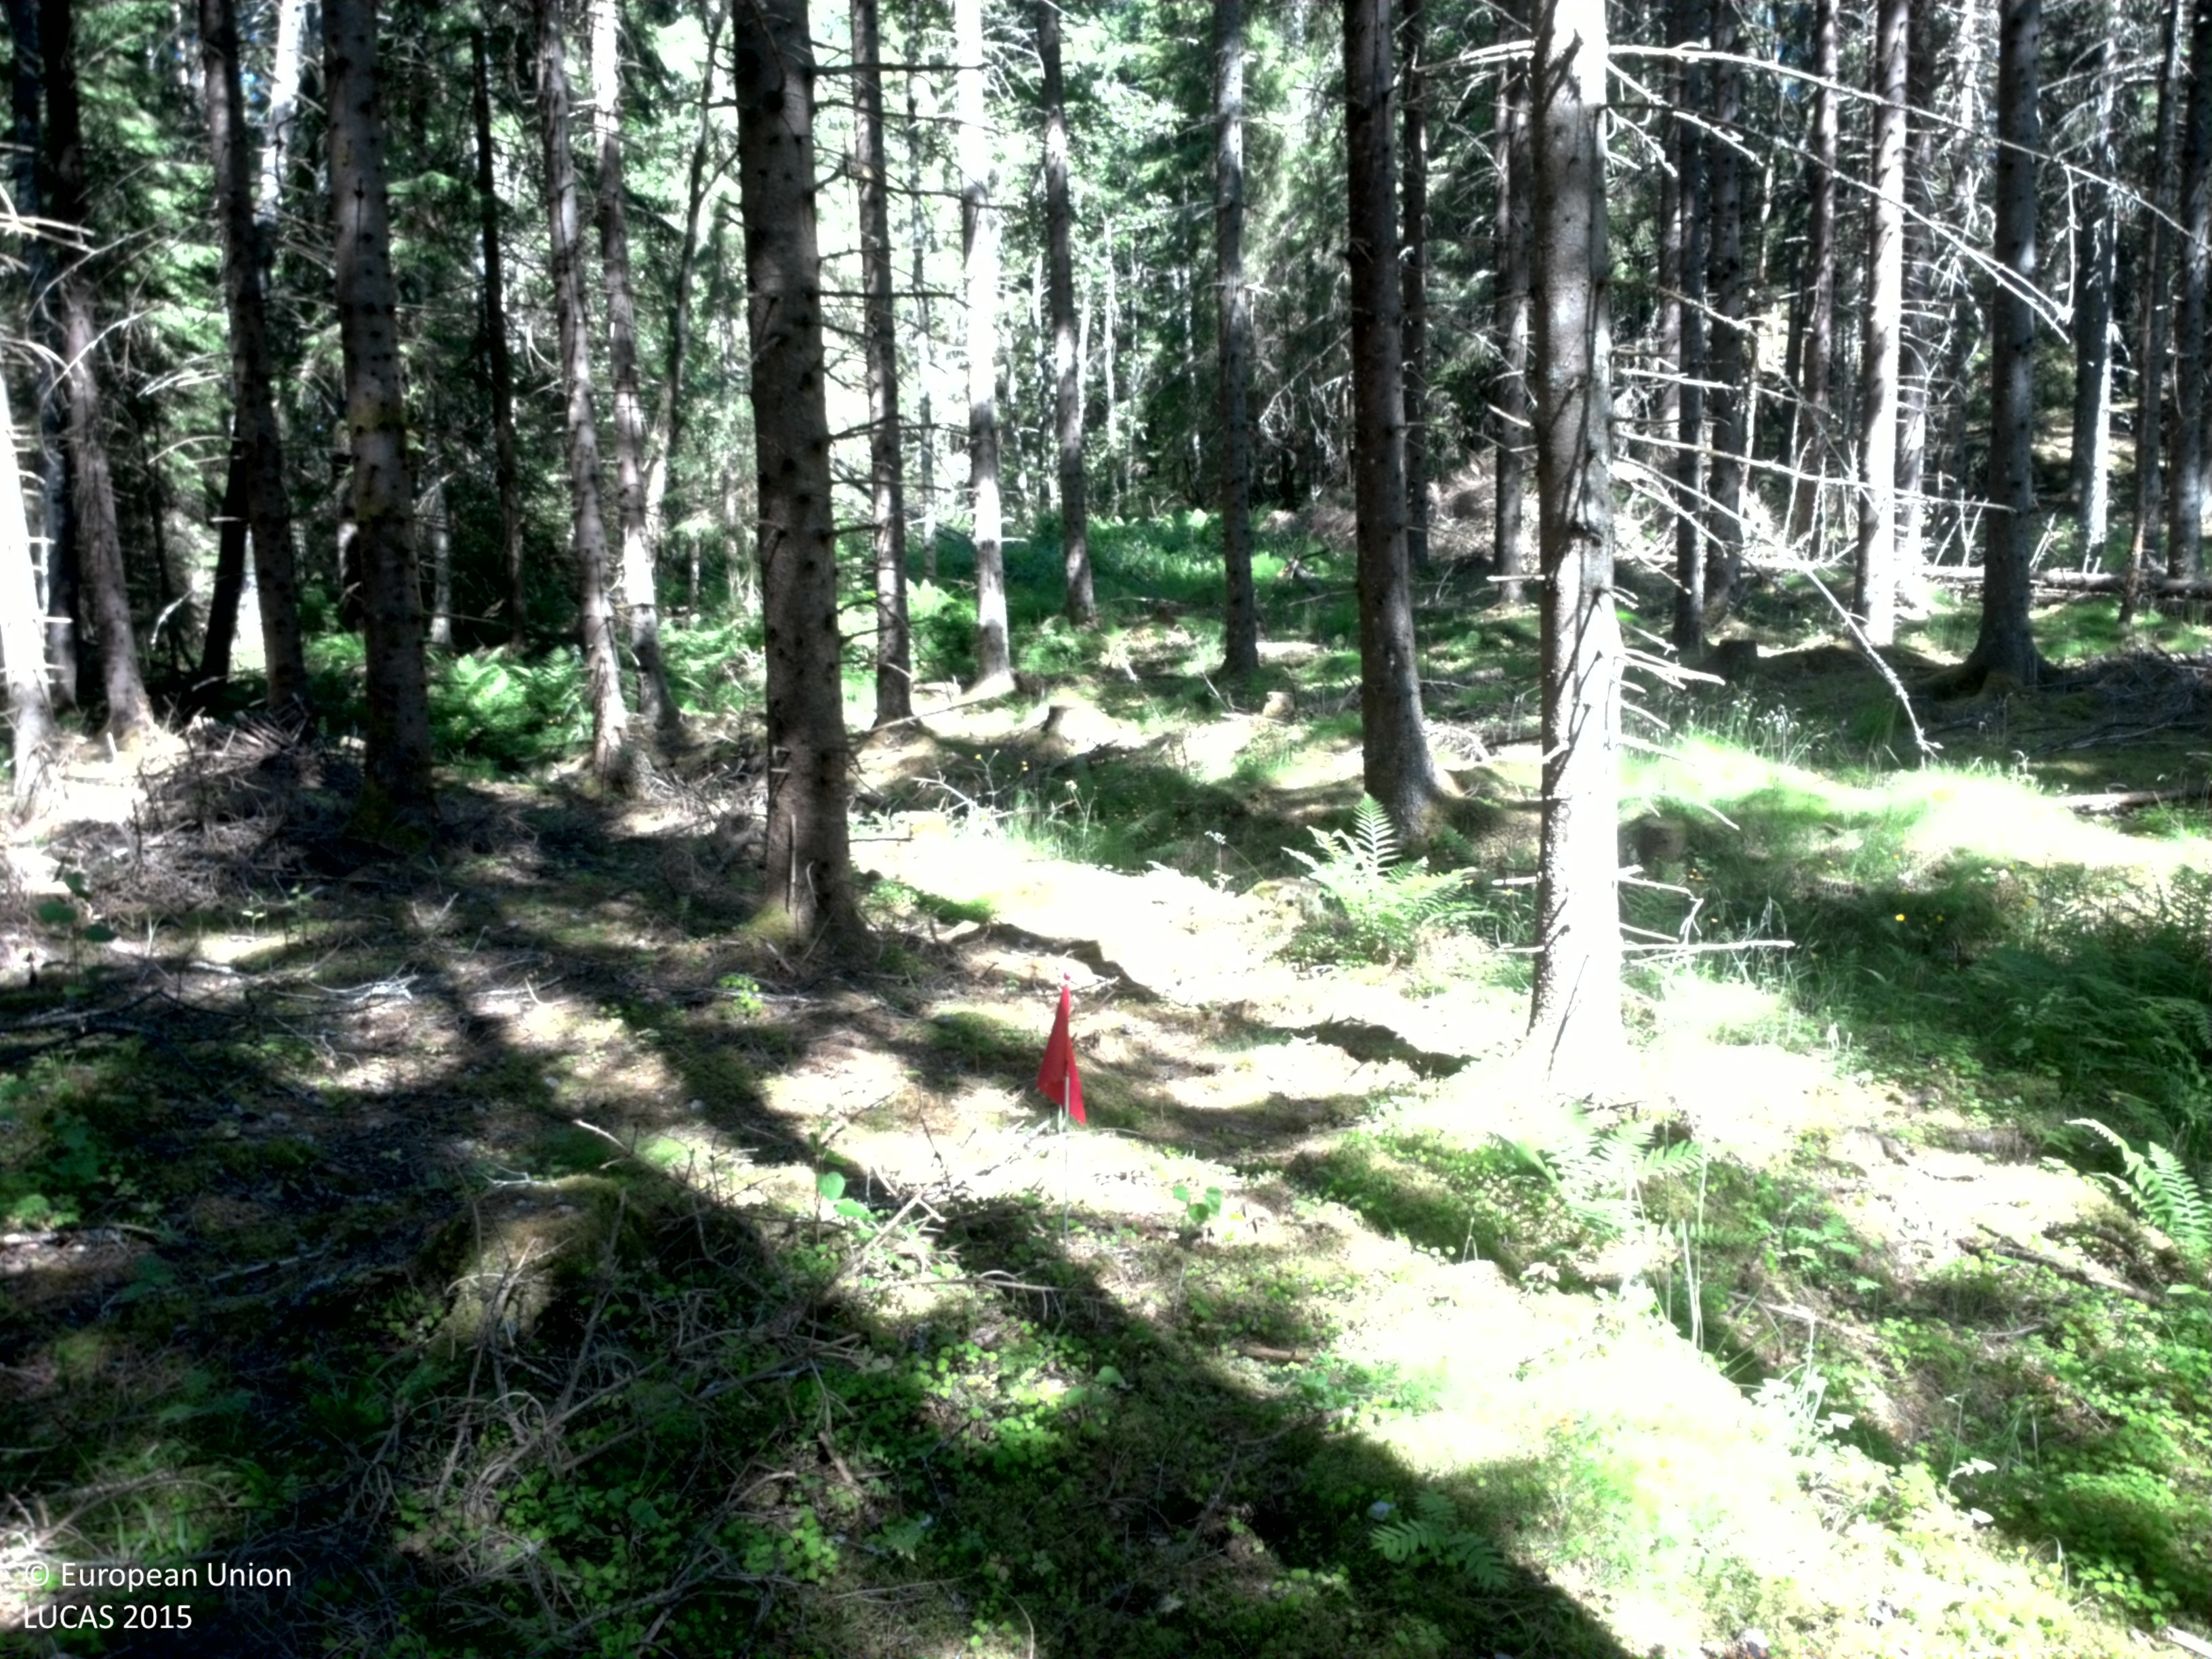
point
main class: Woodland
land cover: Spruce dominated coniferous woodland
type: boreal forest
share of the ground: 50 - 75 %
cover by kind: coniferous forest trees 70 %, lichens and mosses 15 %, broadleaved forest trees 5 %, shrubs 5 %, herbaceous plants 5 %
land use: Forestry
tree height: > 5 m
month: July
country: SE
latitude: 59.8422
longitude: 12.0108
